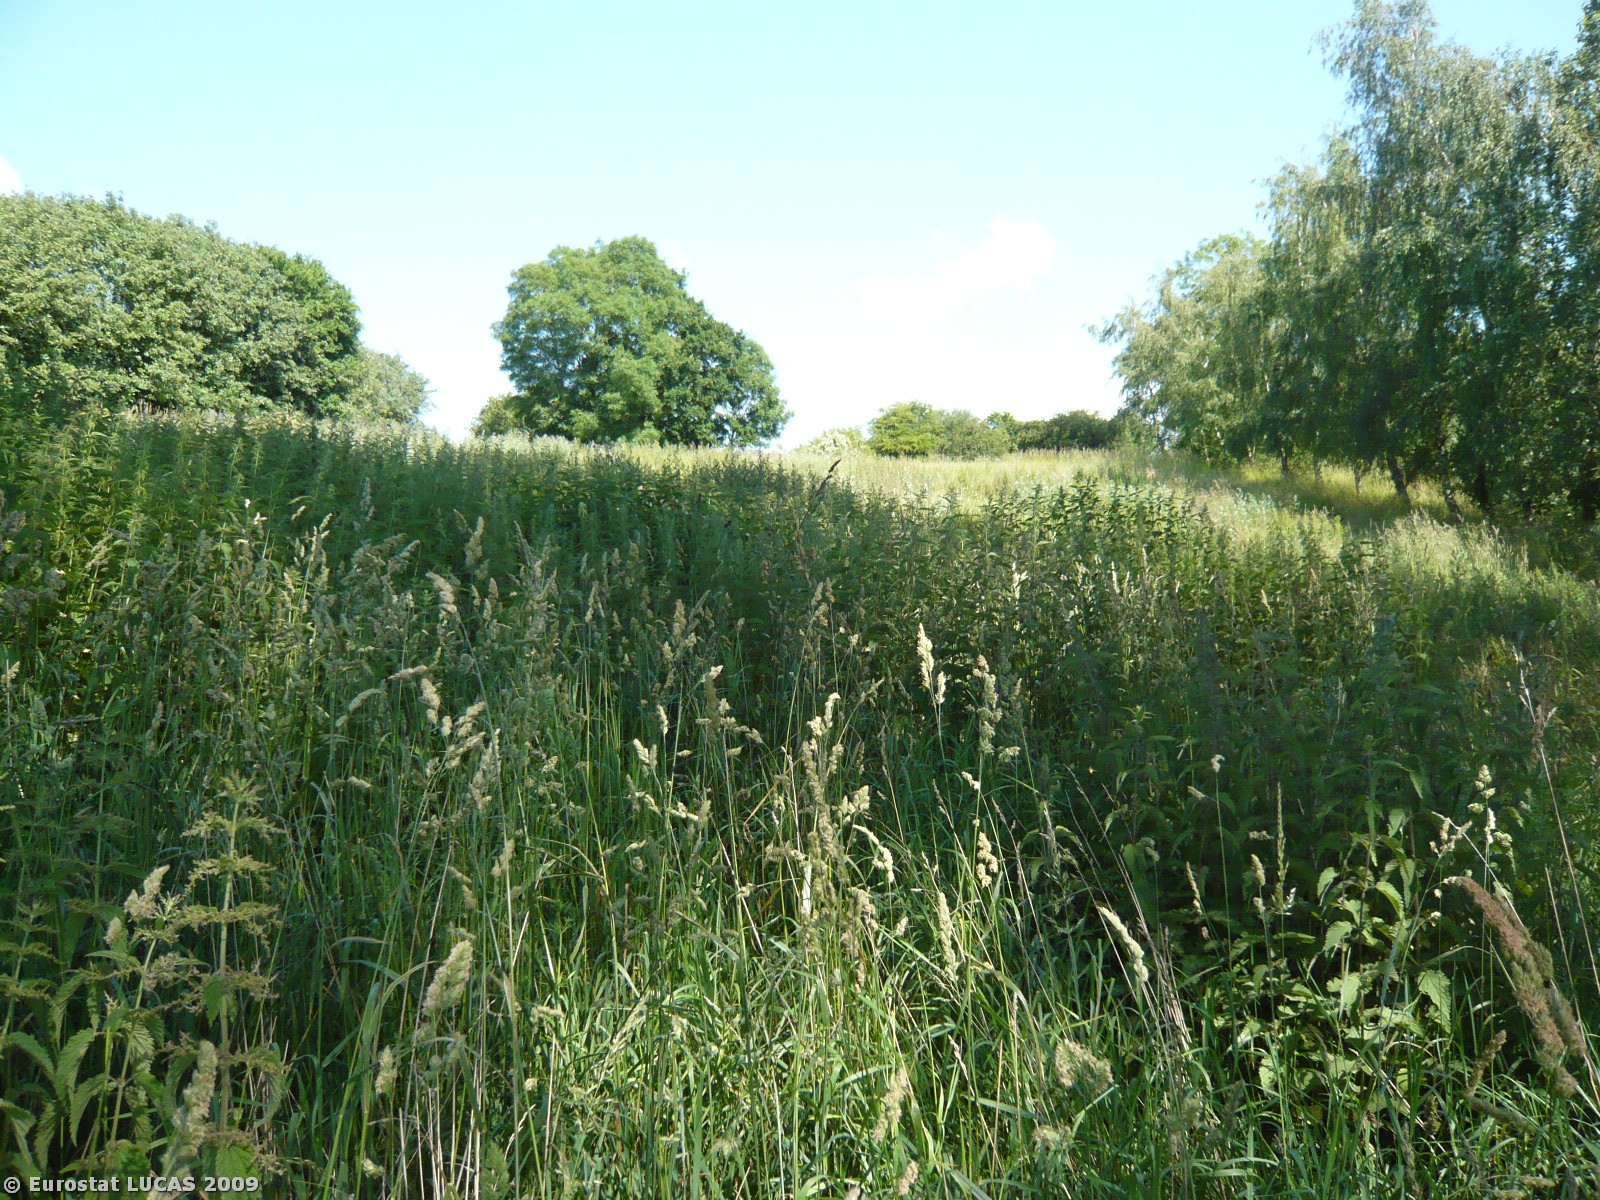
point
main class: Grassland
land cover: Spontaneously vegetated surfaces
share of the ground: > 75 %
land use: Fallow land
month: July
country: DK
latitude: 55.3788
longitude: 10.1734
